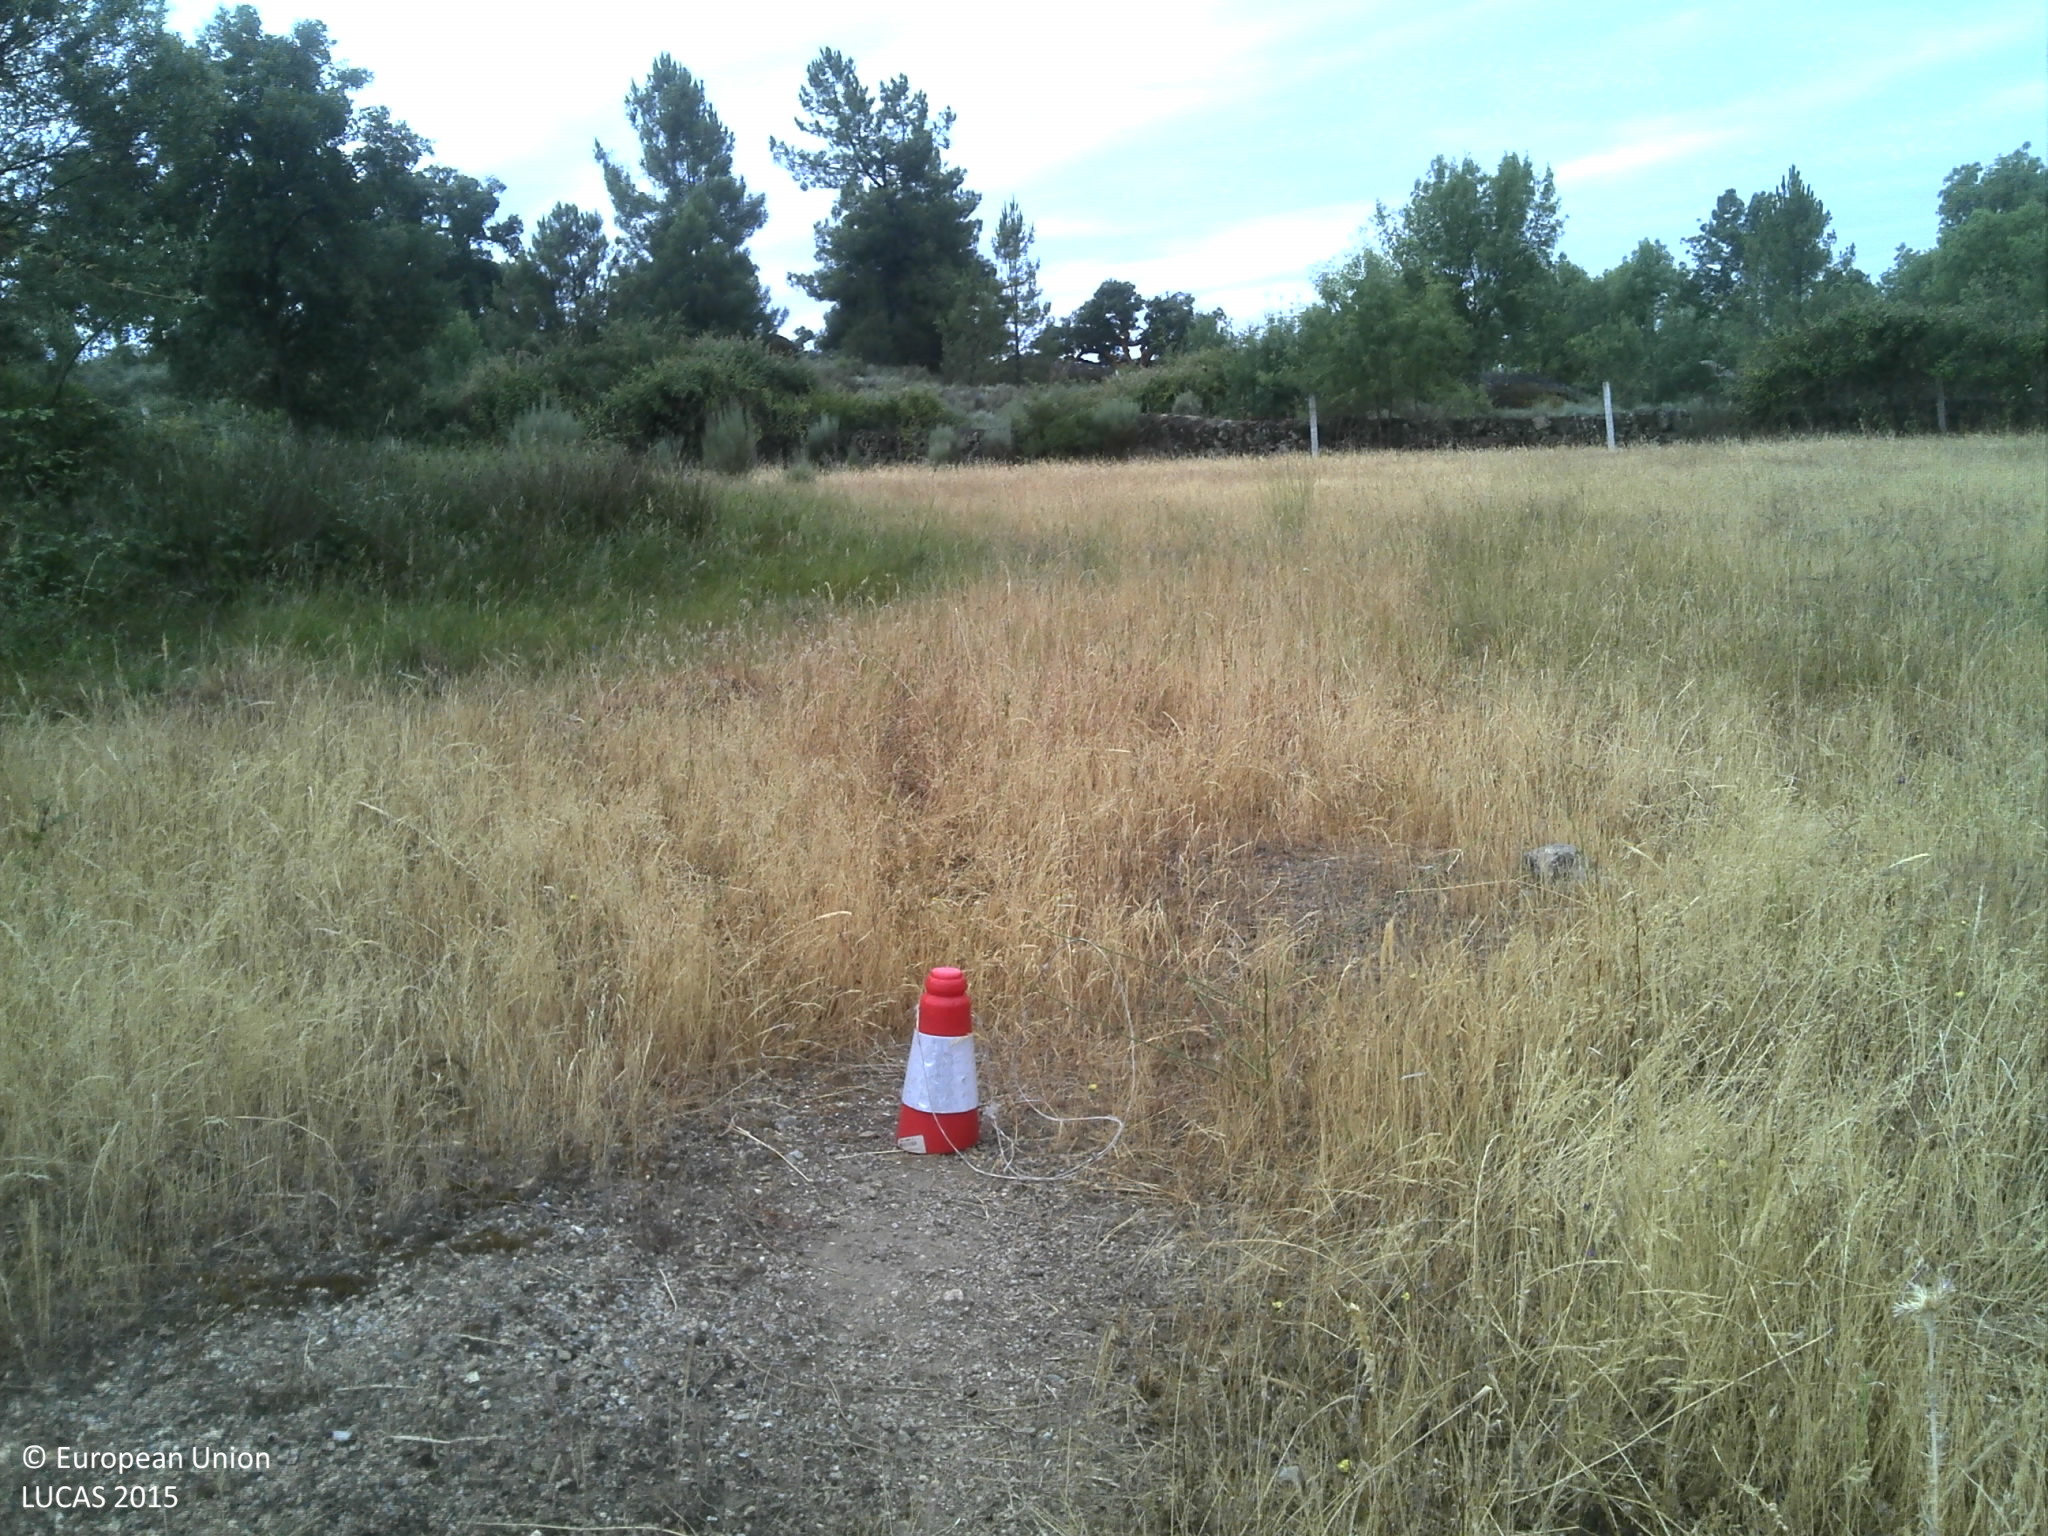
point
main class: Grassland
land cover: Grassland without tree/shrub cover
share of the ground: 50 - 75 %
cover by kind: herbaceous plants 60 %, unconsolidated bare surface 40 %
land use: Agriculture (excluding fallow land and kitchen gardens)
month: June
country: PT
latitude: 40.1553
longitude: -7.2029
